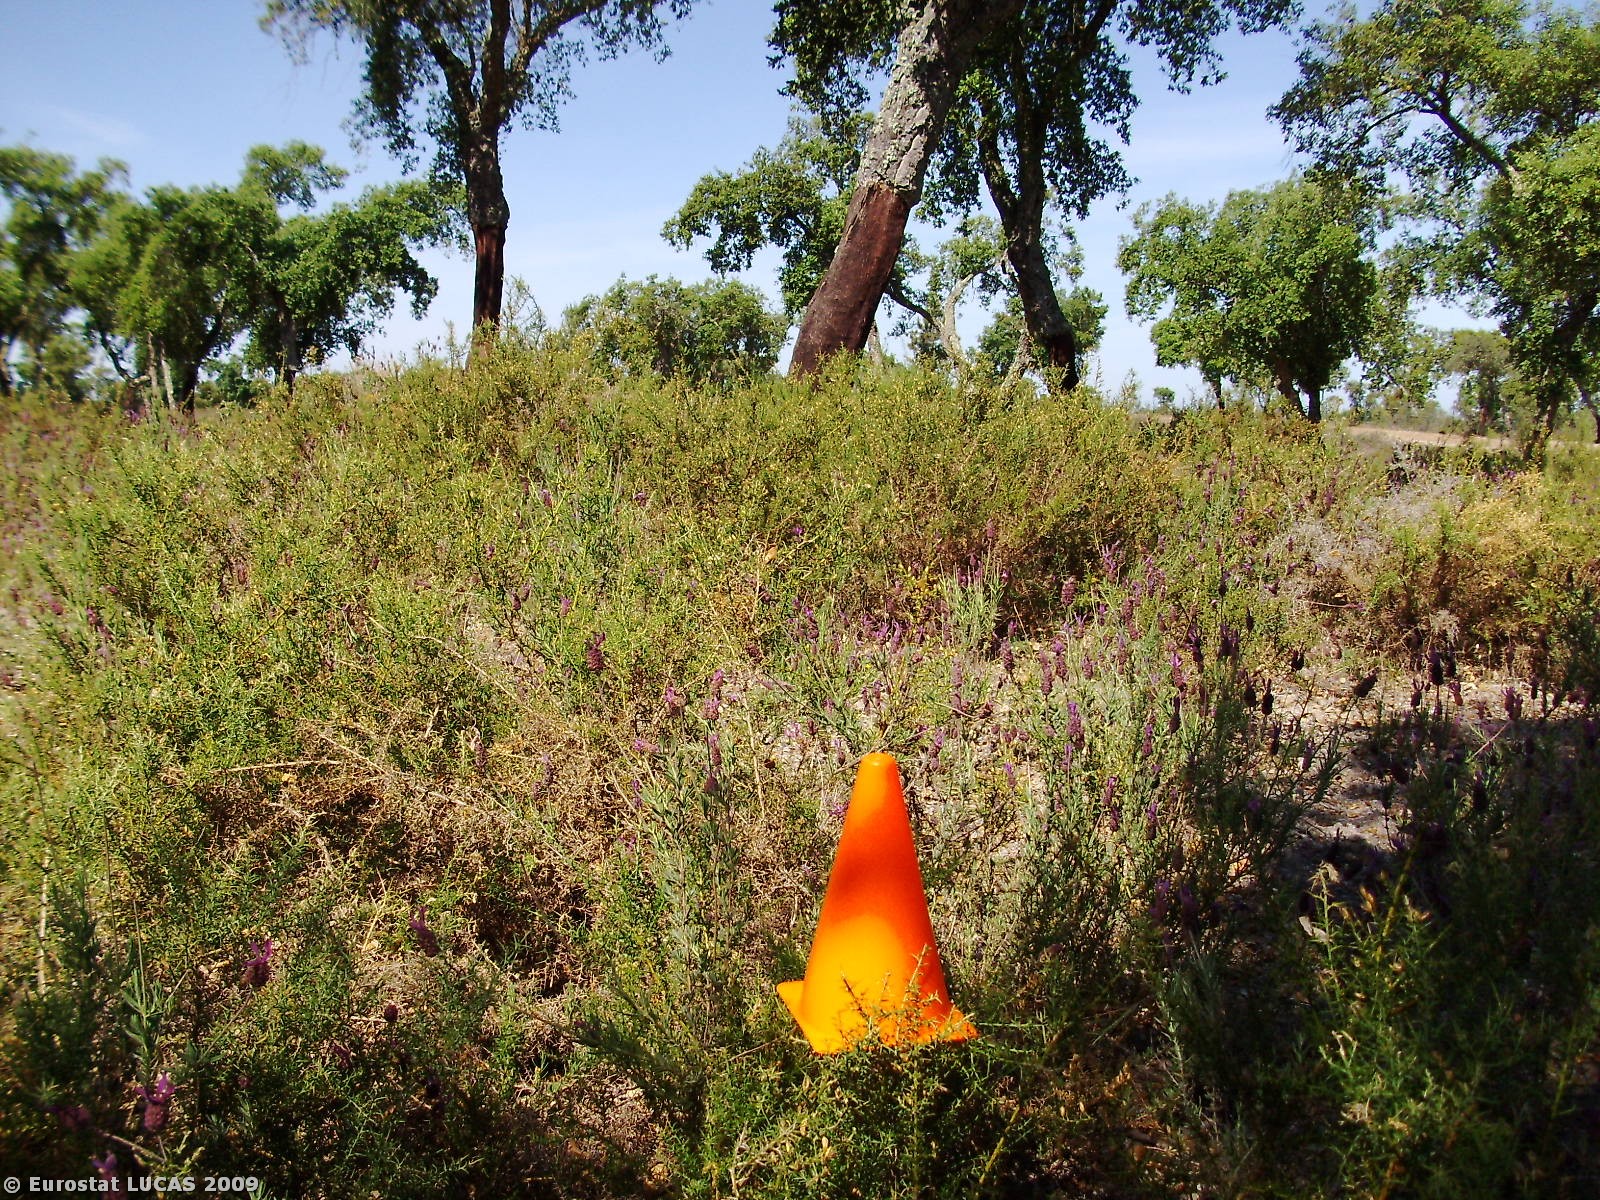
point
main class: Woodland
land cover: Broadleaved woodland
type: broadleaved evergreen forest
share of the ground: 50 - 75 %
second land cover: Shrubland with sparse tree cover
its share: 25 - 50 %
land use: Forestry
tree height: > 5 m
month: May
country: PT
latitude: 39.1941
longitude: -7.9169
